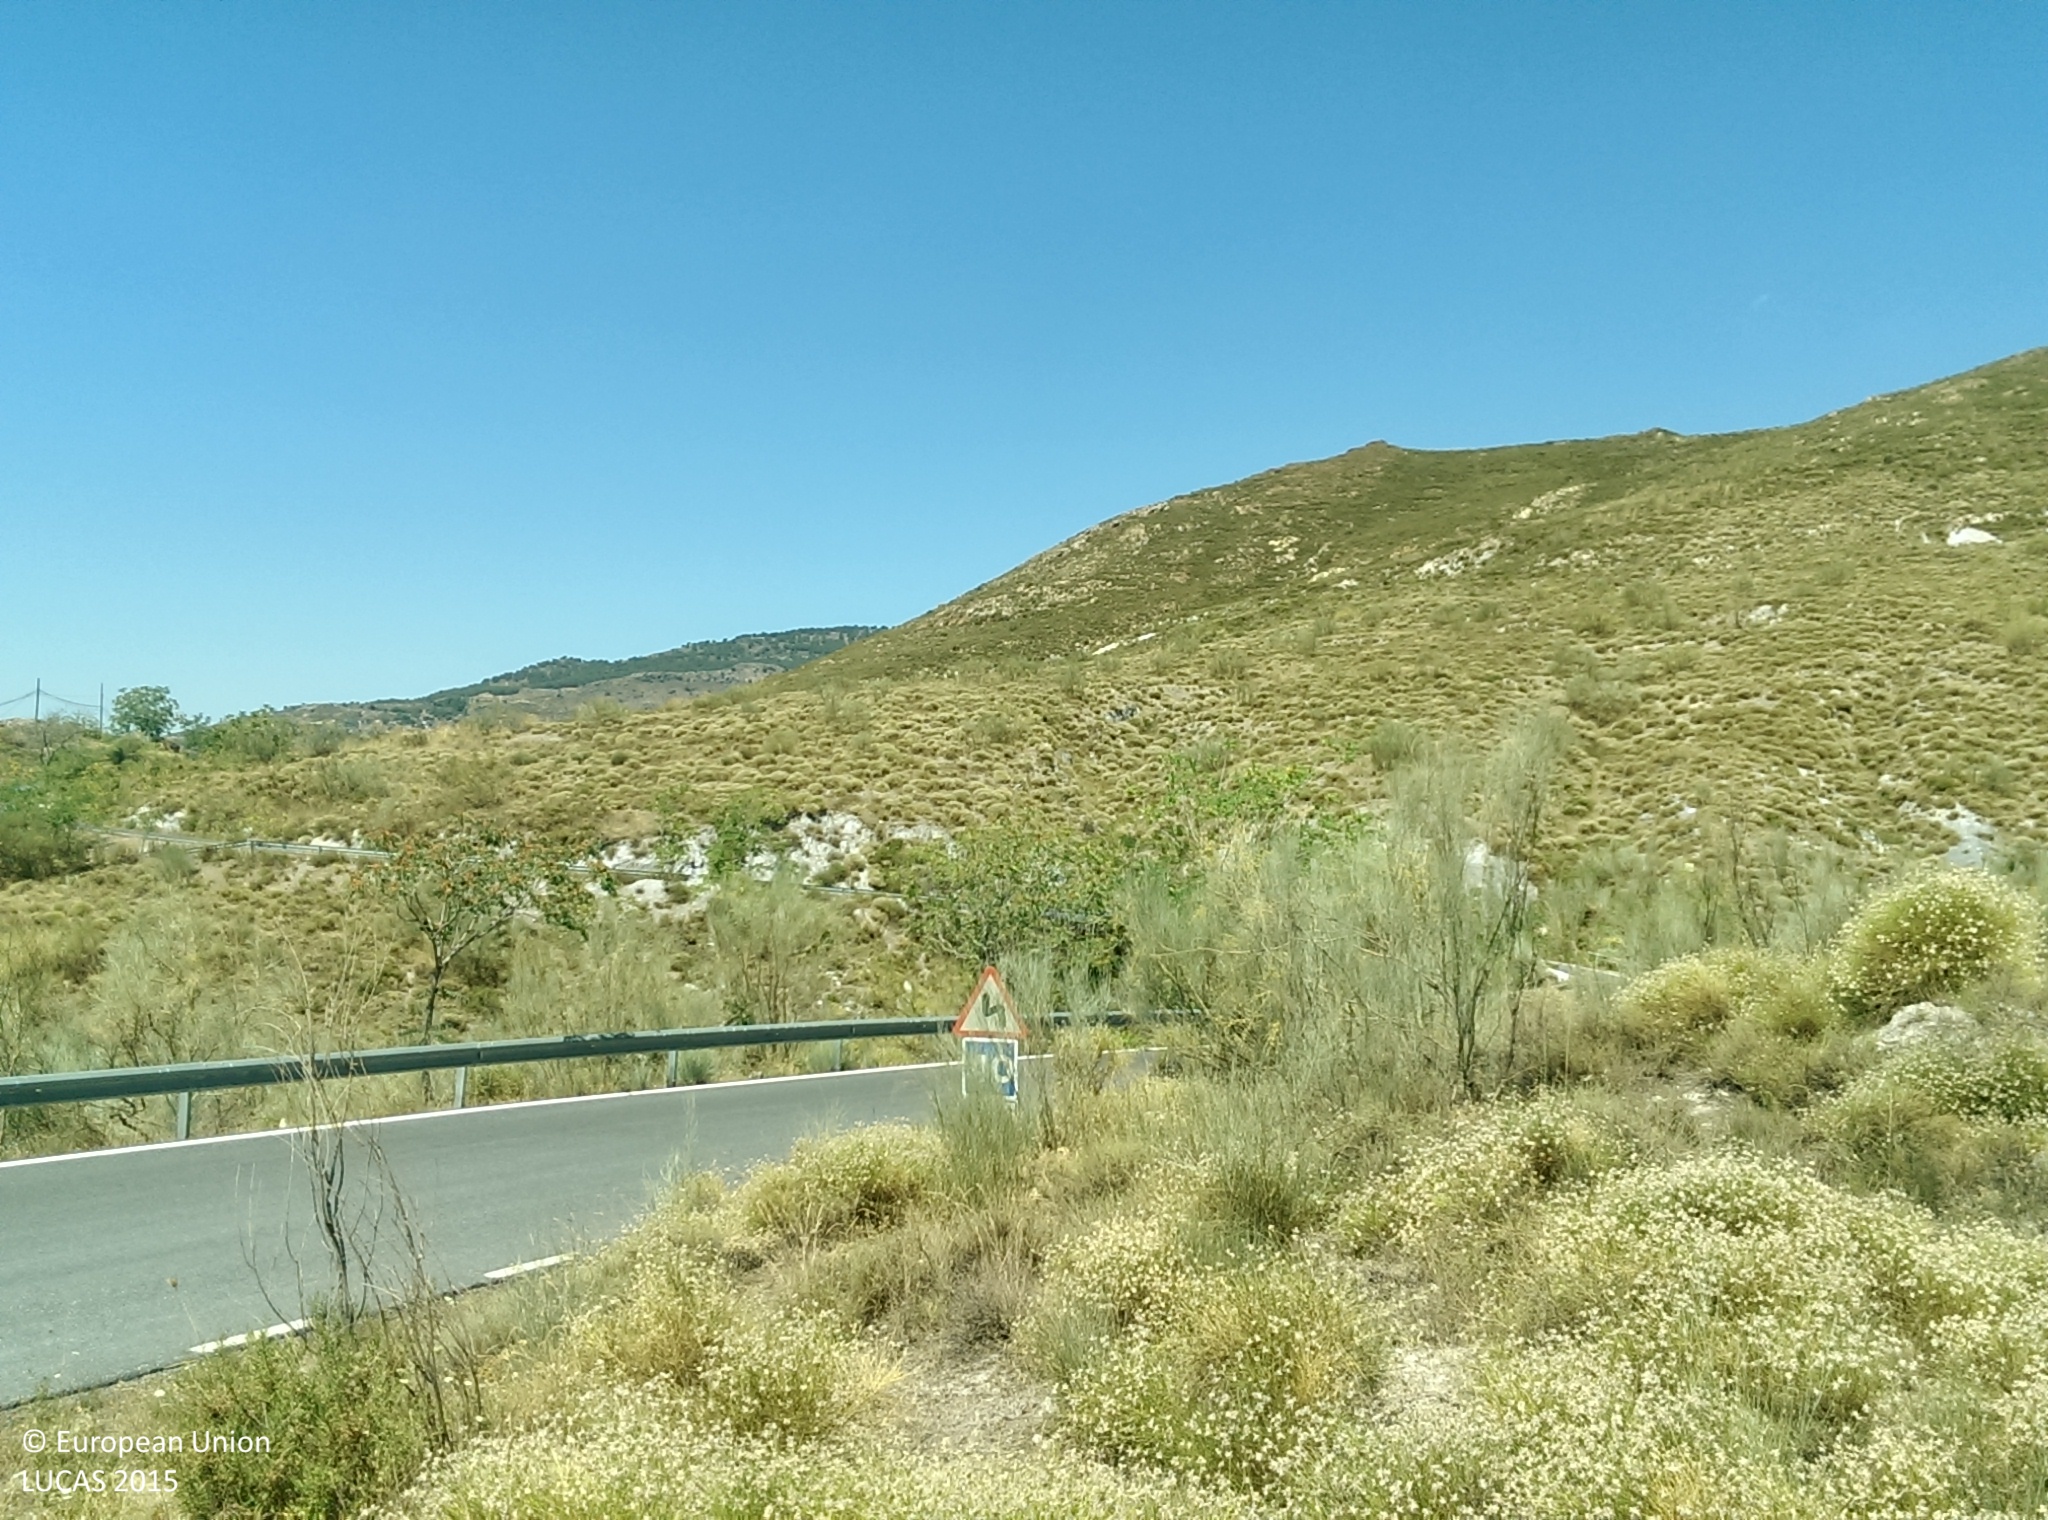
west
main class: Shrubland
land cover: Shrubland without tree cover
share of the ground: > 75 %
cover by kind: shrubs 75 %, herbaceous plants 20 %, unconsolidated bare surface 5 %
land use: Semi-natural and natural areas not in use
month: July
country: ES
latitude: 36.9787
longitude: -3.1369
